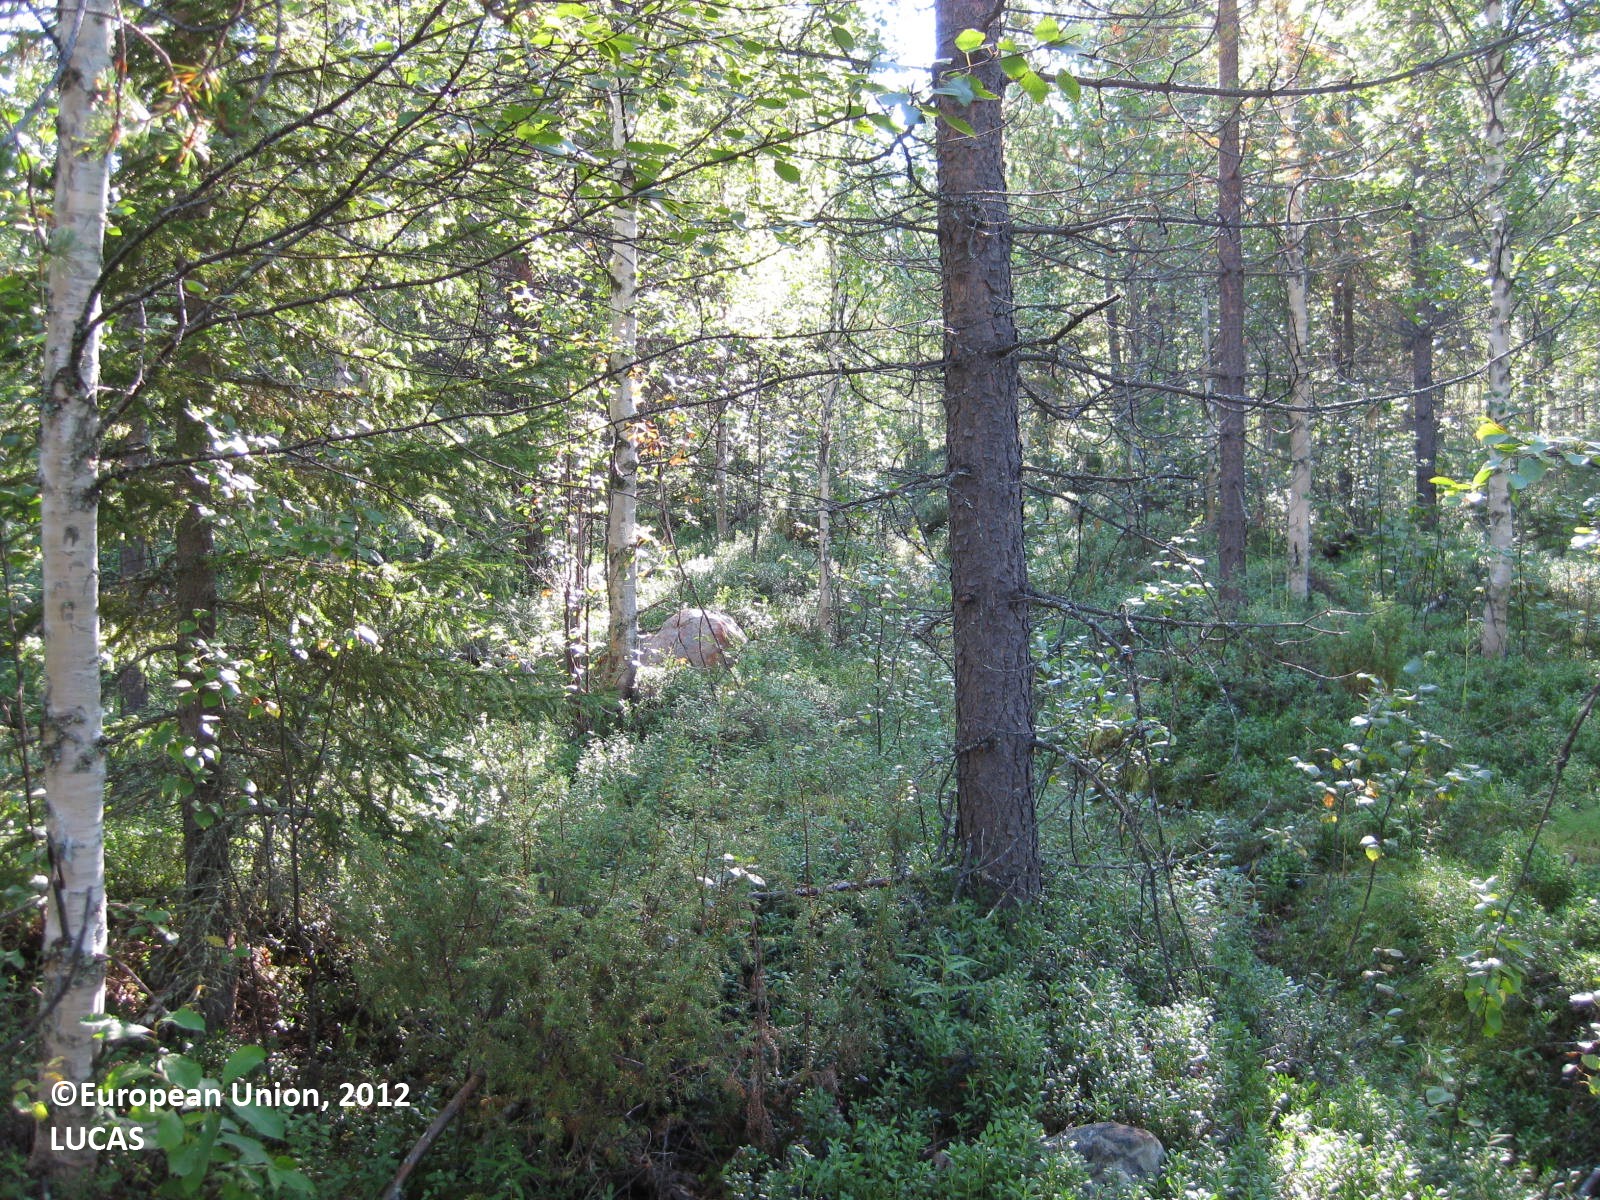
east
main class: Woodland
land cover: Pine dominated mixed woodland
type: boreal forest
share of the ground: > 75 %
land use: Forestry
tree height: > 5 m
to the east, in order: Pine dominated mixed woodland; Ditches and canals; Pine dominated mixed woodland; Ditches and canals; Pine dominated mixed woodland; Ditches and canals; Pine dominated mixed woodland; Ditches and canals; Pine dominated mixed woodland; Other mixed woodland; Ditches and canals; Pine dominated mixed woodland; Ditches and canals; Pine dominated mixed woodland; Ditches and canals; Pine dominated mixed woodland; Ditches and canals; Pine dominated mixed woodland; Ditches and canals; Other mixed woodland; Fences; Pine dominated mixed woodland
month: August
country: FI
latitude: 66.6641
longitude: 29.1464
